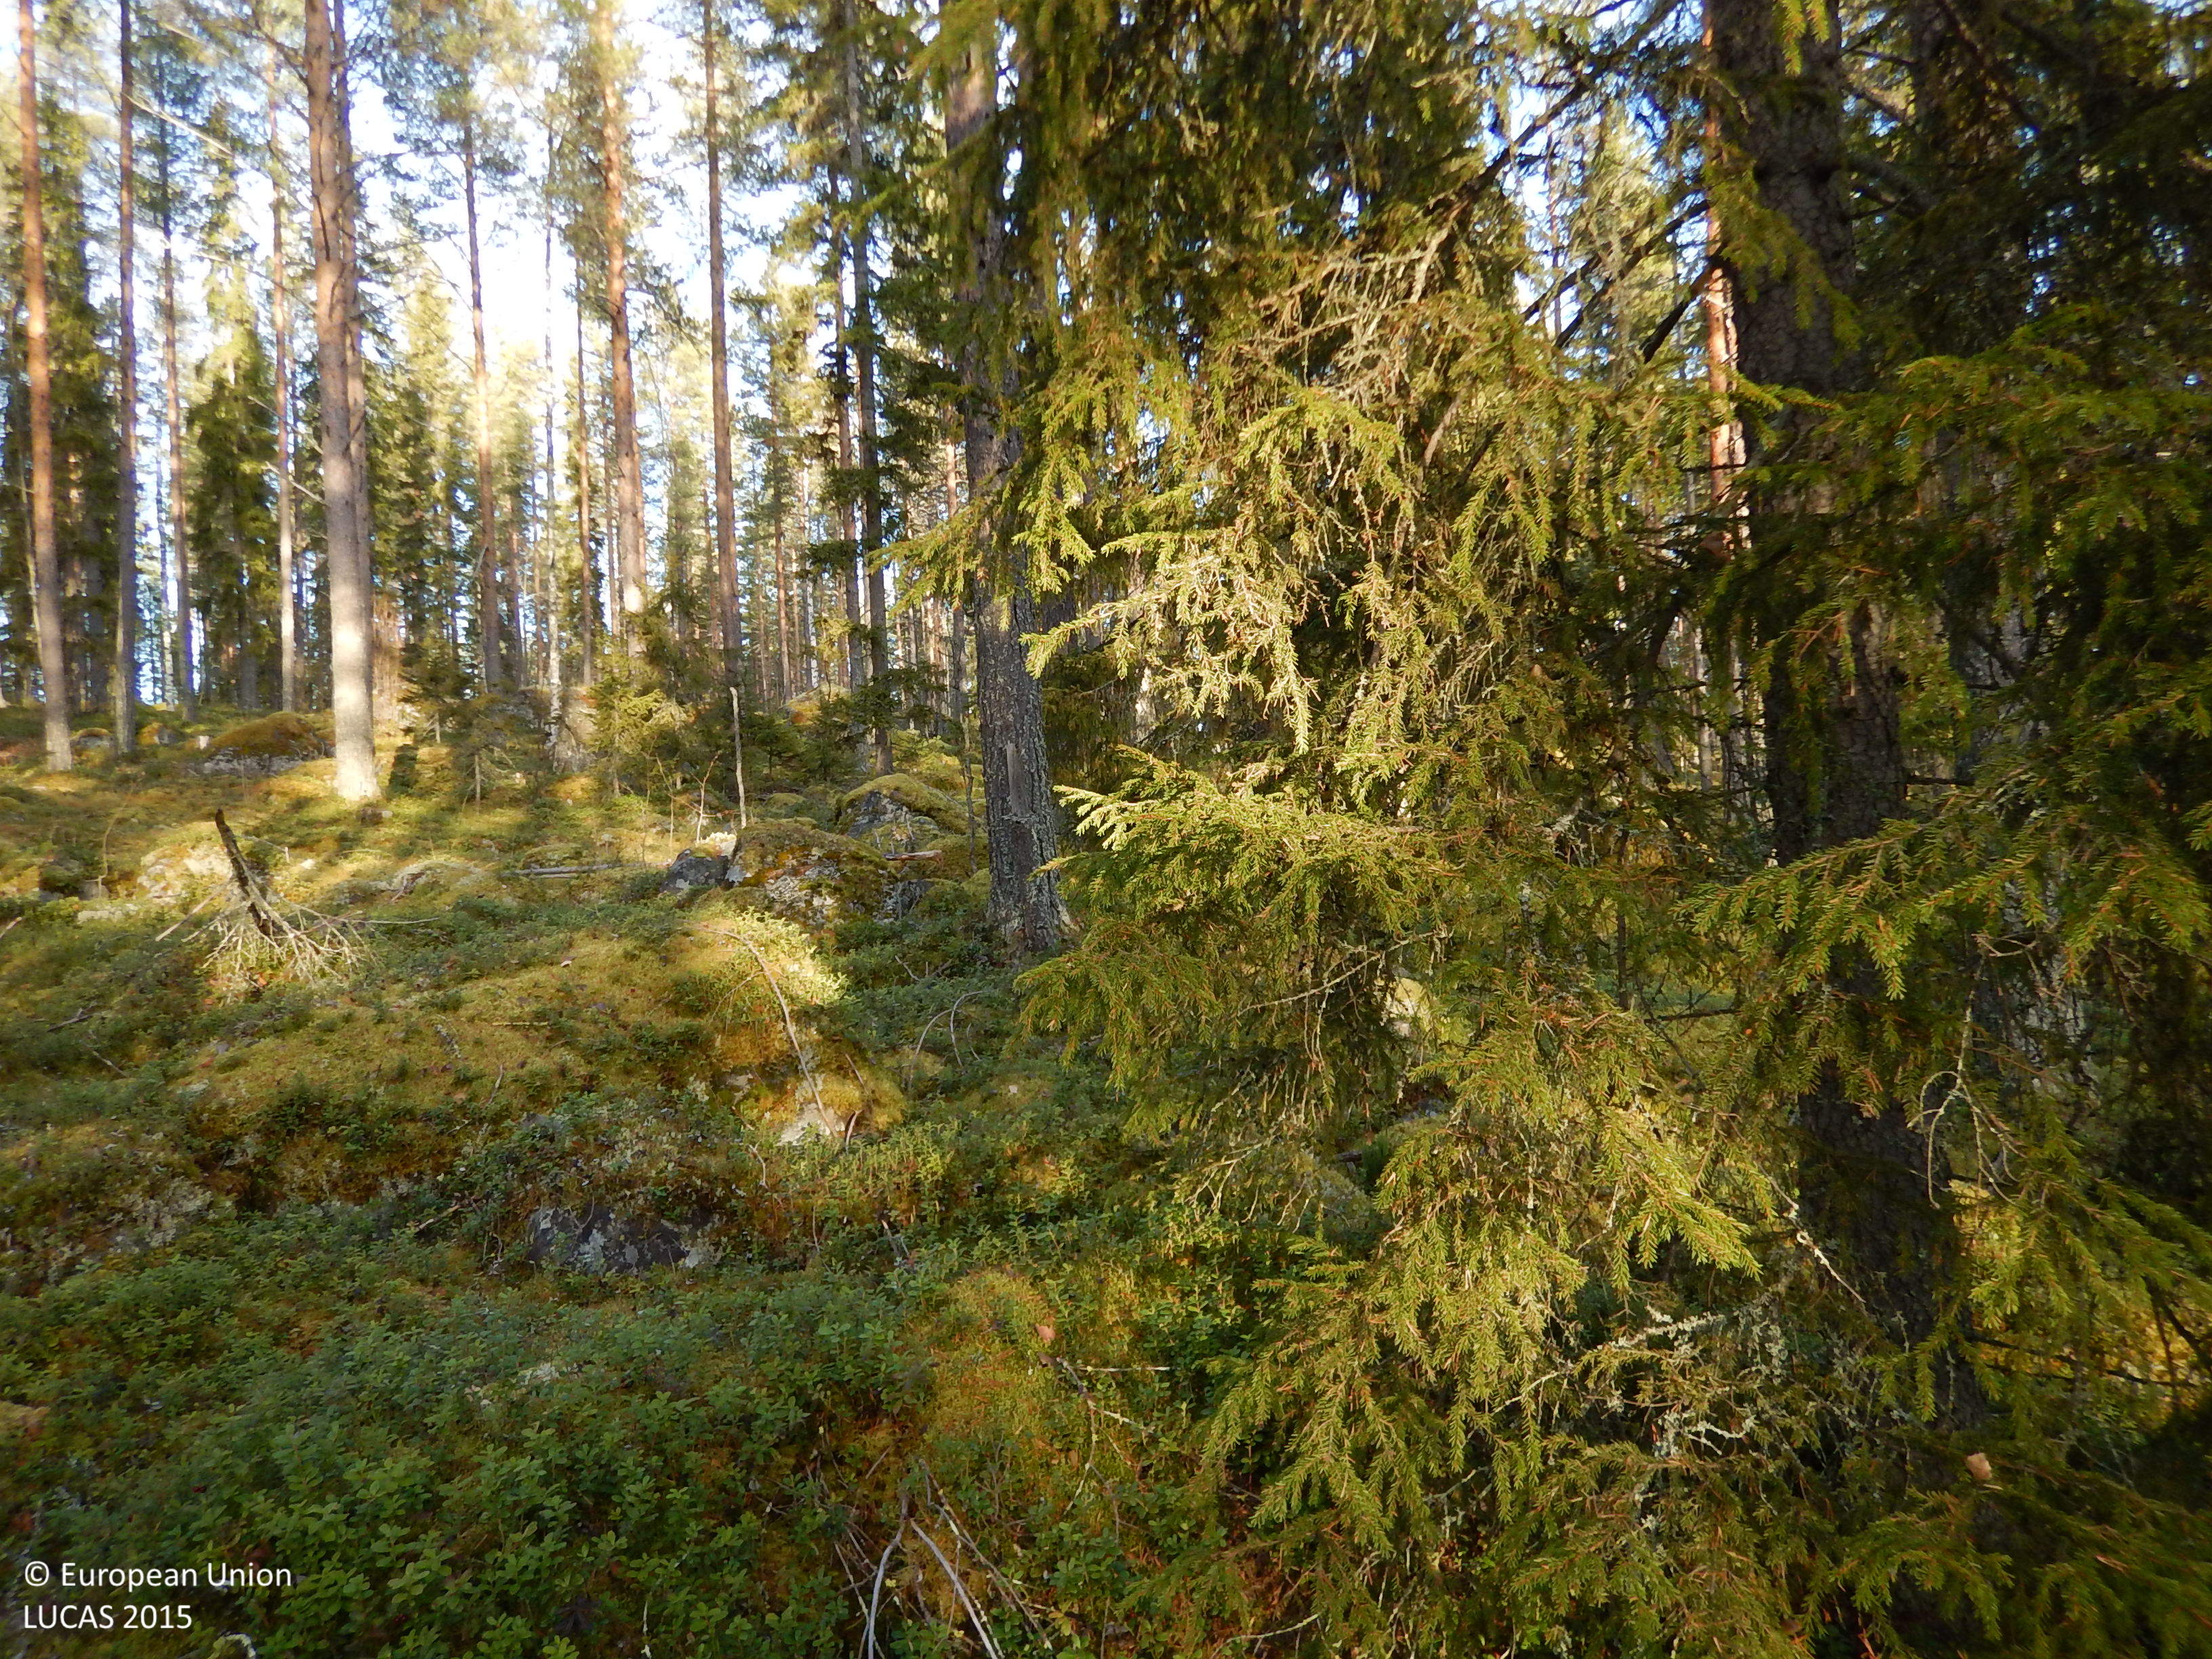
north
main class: Woodland
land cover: Other coniferous woodland
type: boreal forest
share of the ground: 50 - 75 %
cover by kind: coniferous forest trees 60 %, shrubs 15 %, lichens and mosses 15 %, broadleaved forest trees 5 %, herbaceous plants 5 %
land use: Forestry
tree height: > 5 m
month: November
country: SE
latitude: 65.1771
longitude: 20.8388
